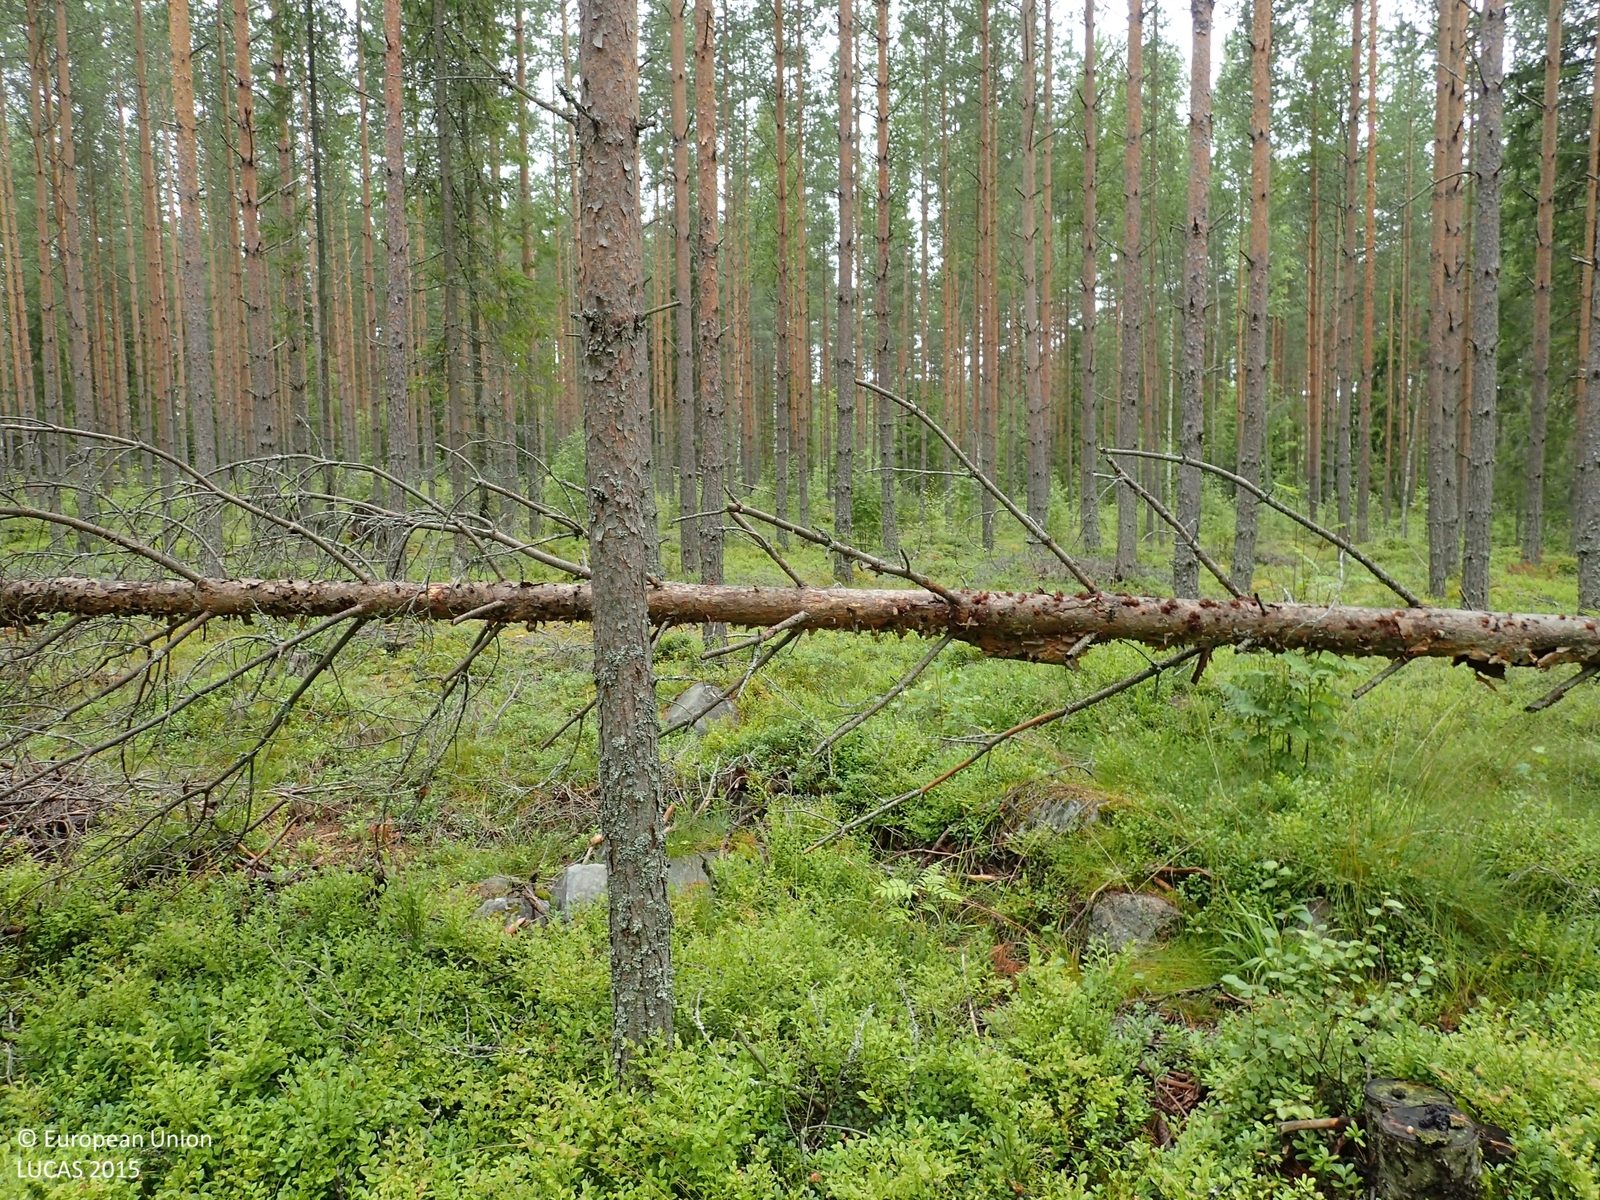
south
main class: Woodland
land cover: Pine dominated coniferous woodland
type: boreal forest
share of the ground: 25 - 50 %
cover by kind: shrubs 60 %, coniferous forest trees 35 %, broadleaved forest trees 5 %
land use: Forestry
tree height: > 5 m
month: July
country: FI
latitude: 62.8183
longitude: 22.7520
